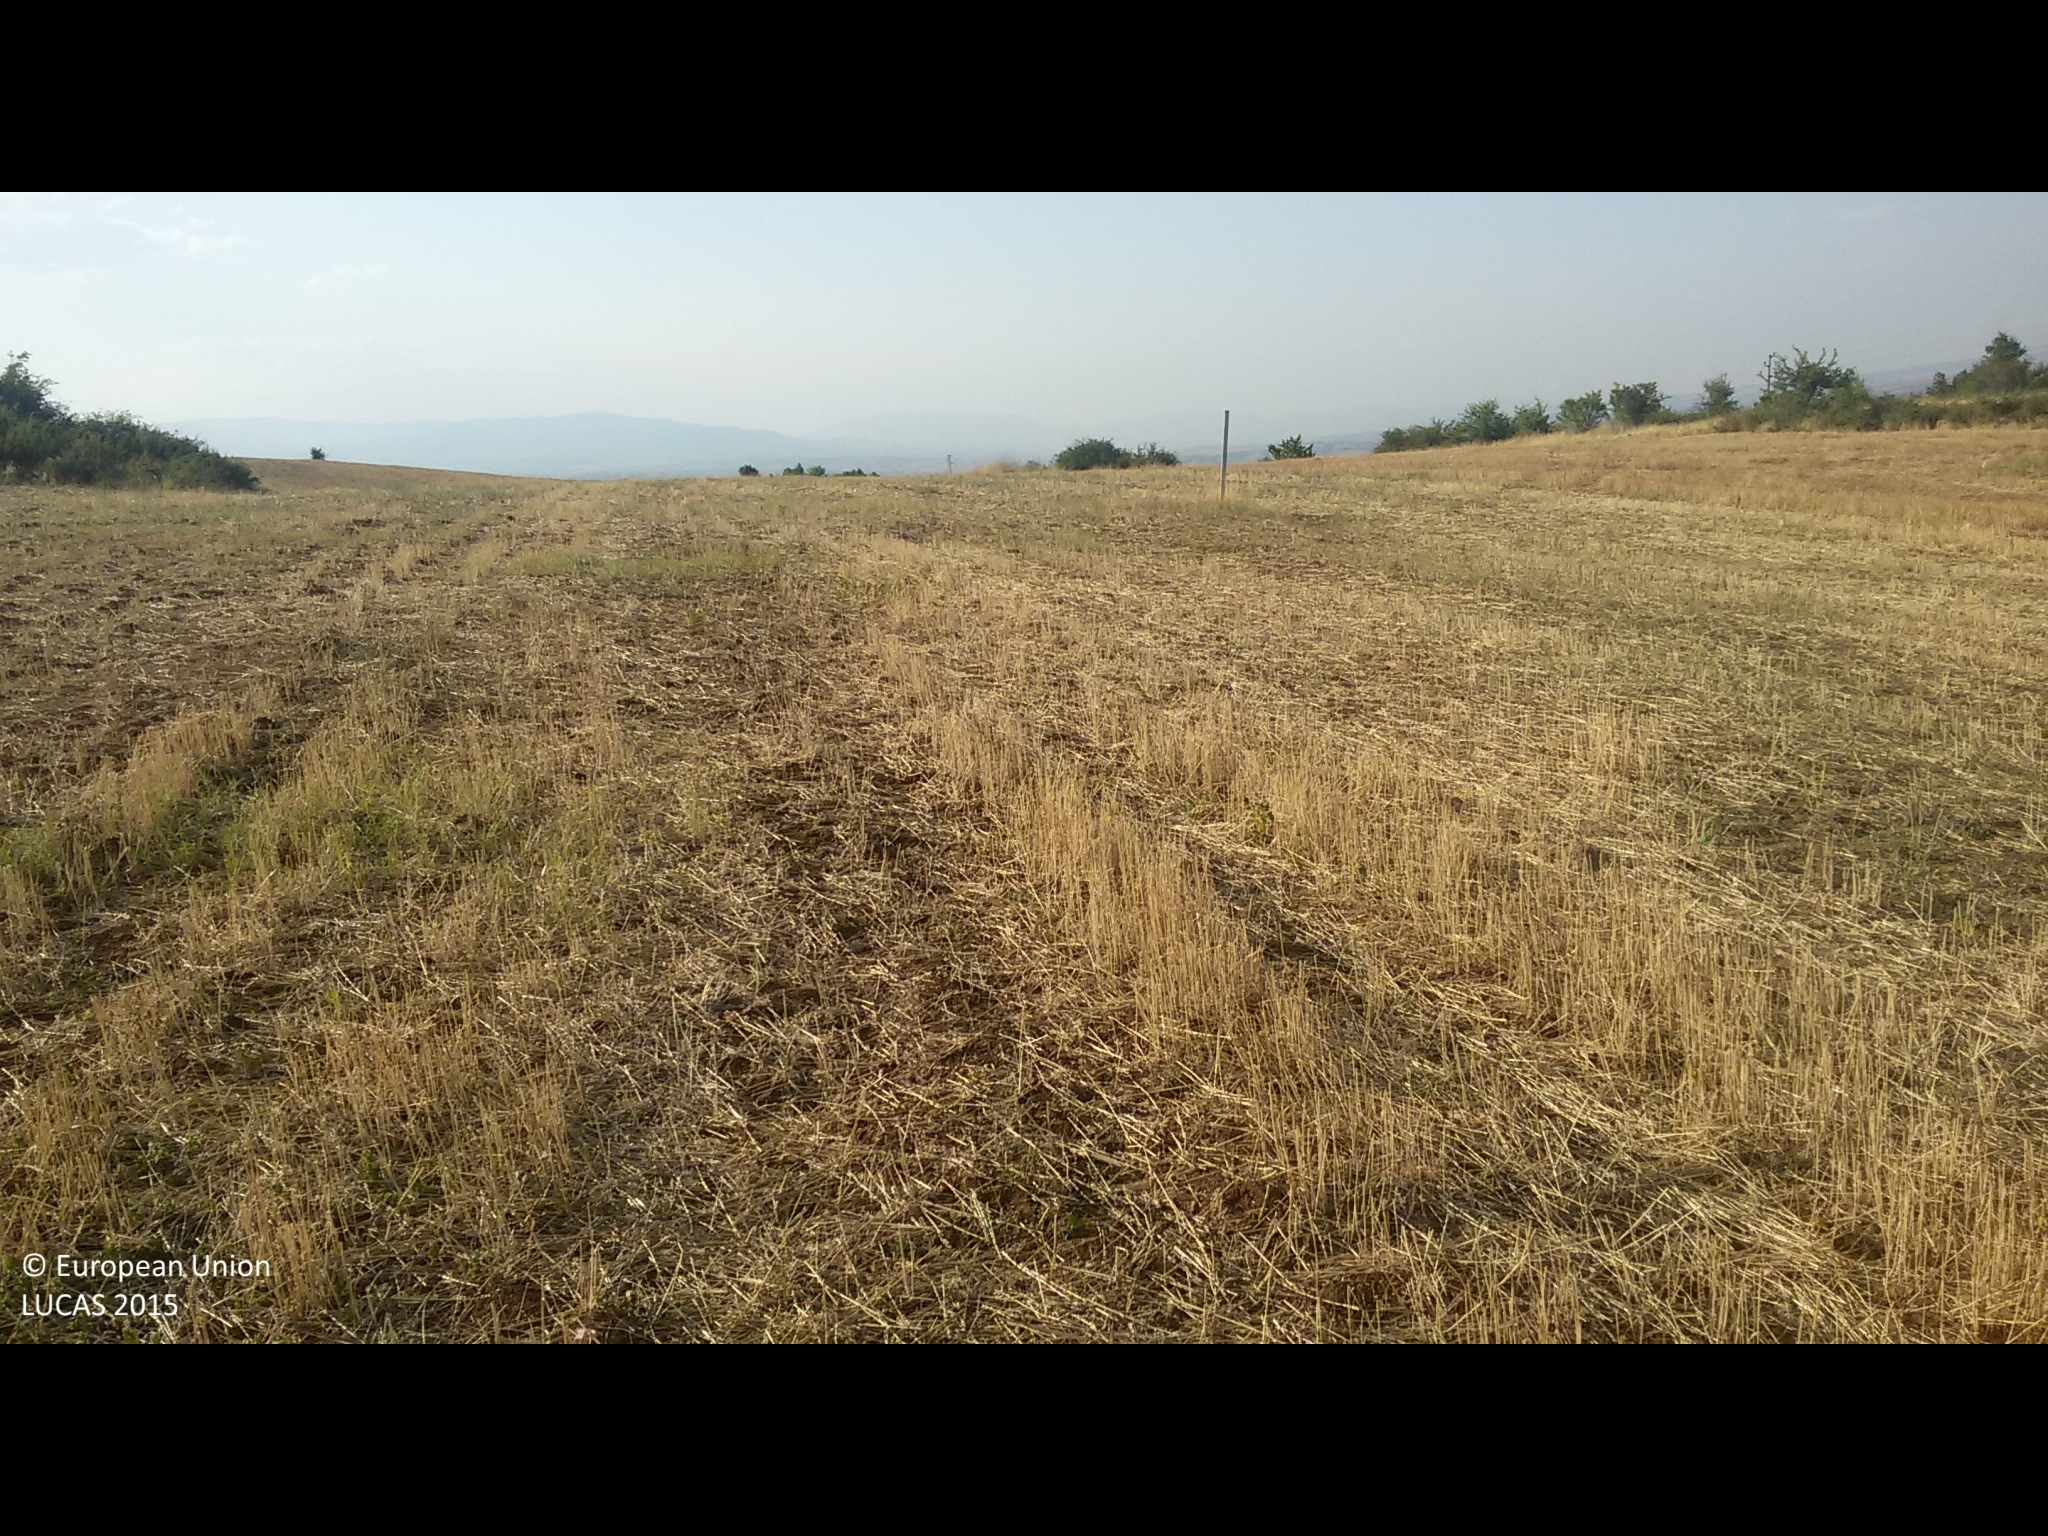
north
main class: Cropland
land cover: Common wheat
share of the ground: 50 - 75 %
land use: Agriculture (excluding fallow land and kitchen gardens)
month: August
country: BG
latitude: 41.9679
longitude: 23.0675
